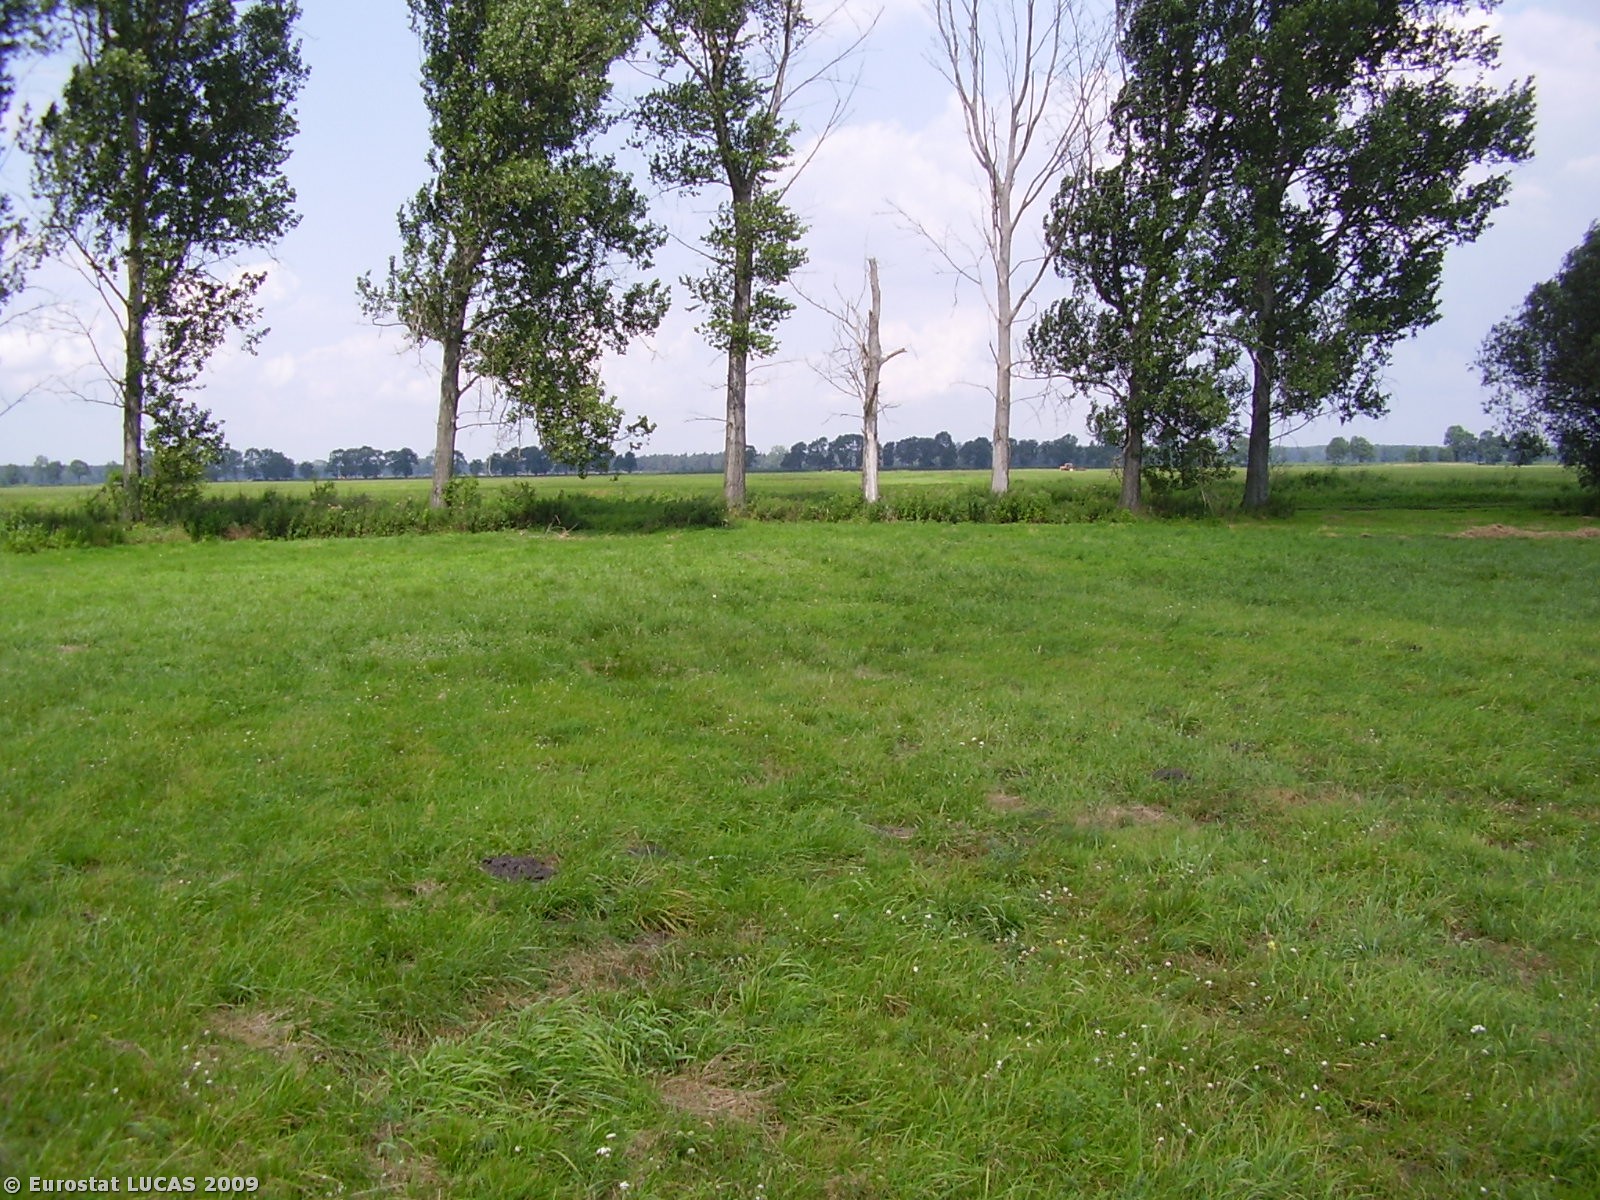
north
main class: Grassland
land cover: Grassland without tree/shrub cover
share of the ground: > 75 %
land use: Agriculture (excluding fallow land and kitchen gardens)
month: July
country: PL
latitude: 52.0499
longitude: 16.2624
